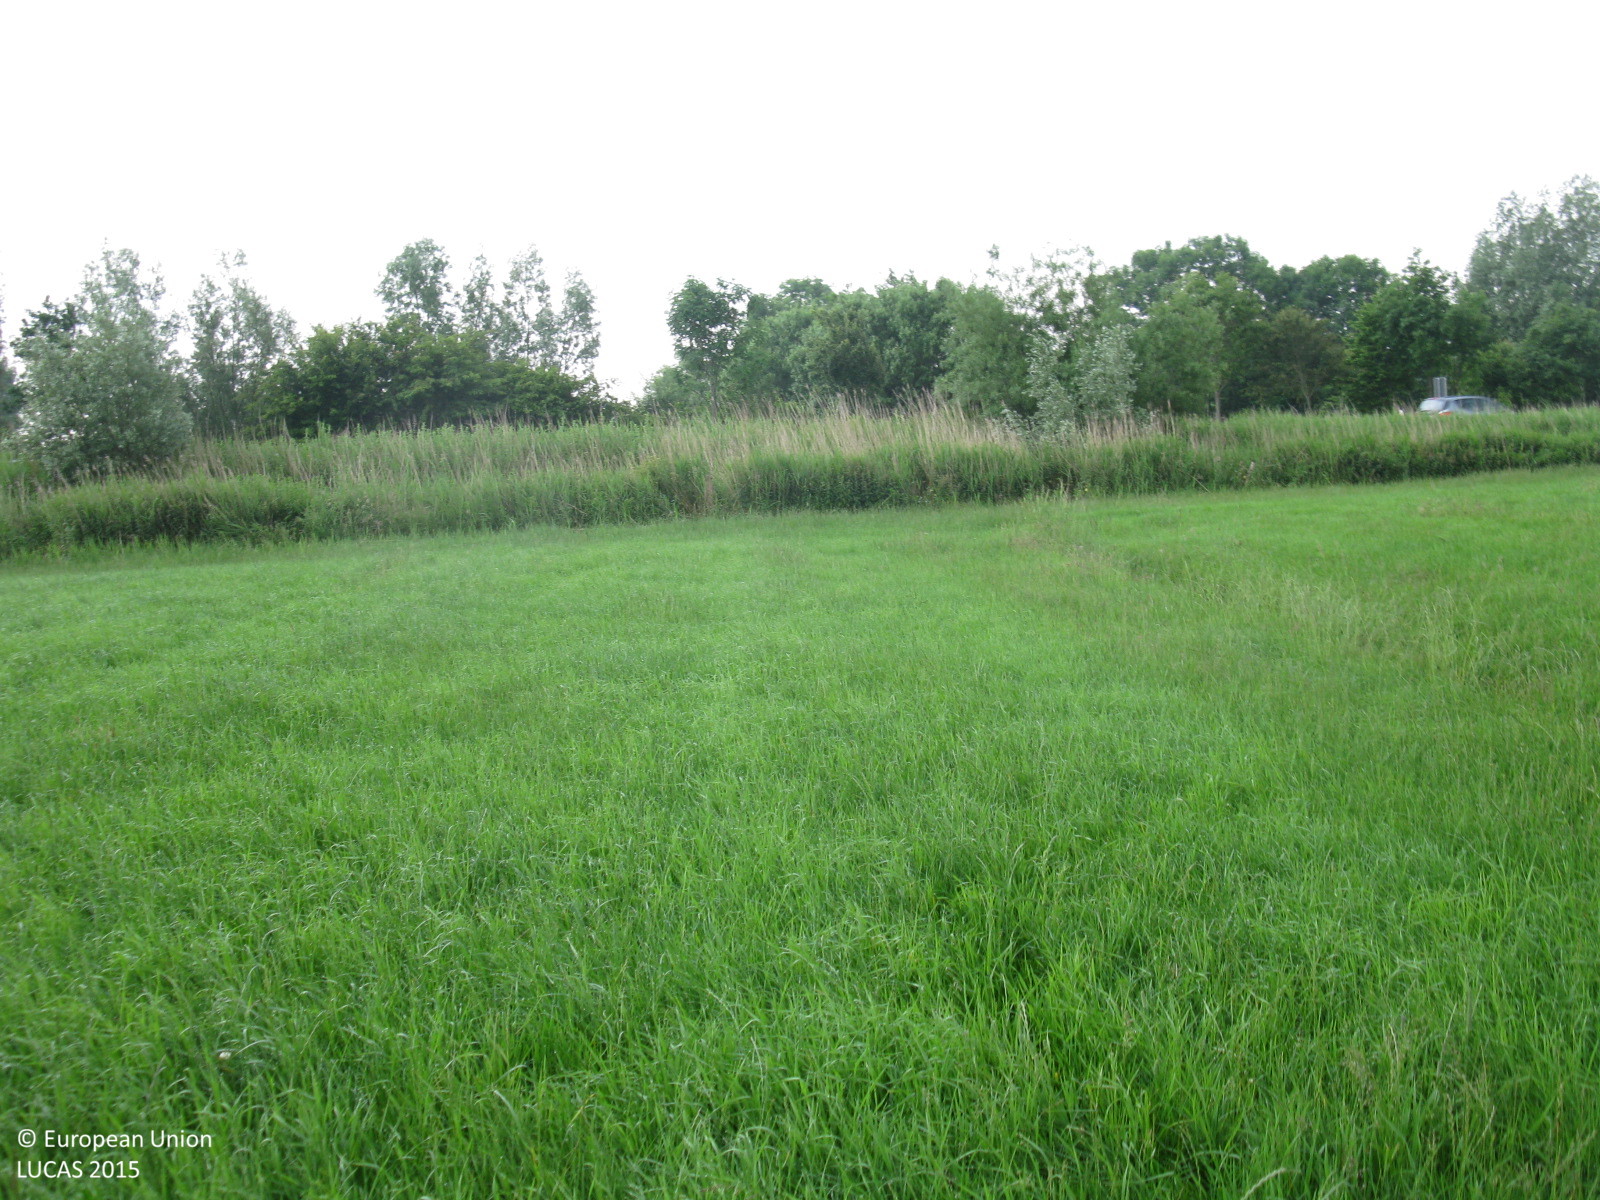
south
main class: Grassland
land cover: Grassland without tree/shrub cover
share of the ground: > 75 %
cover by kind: herbaceous plants 100 %
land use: Agriculture (excluding fallow land and kitchen gardens)
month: June
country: DE
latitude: 53.5810
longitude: 7.8710
